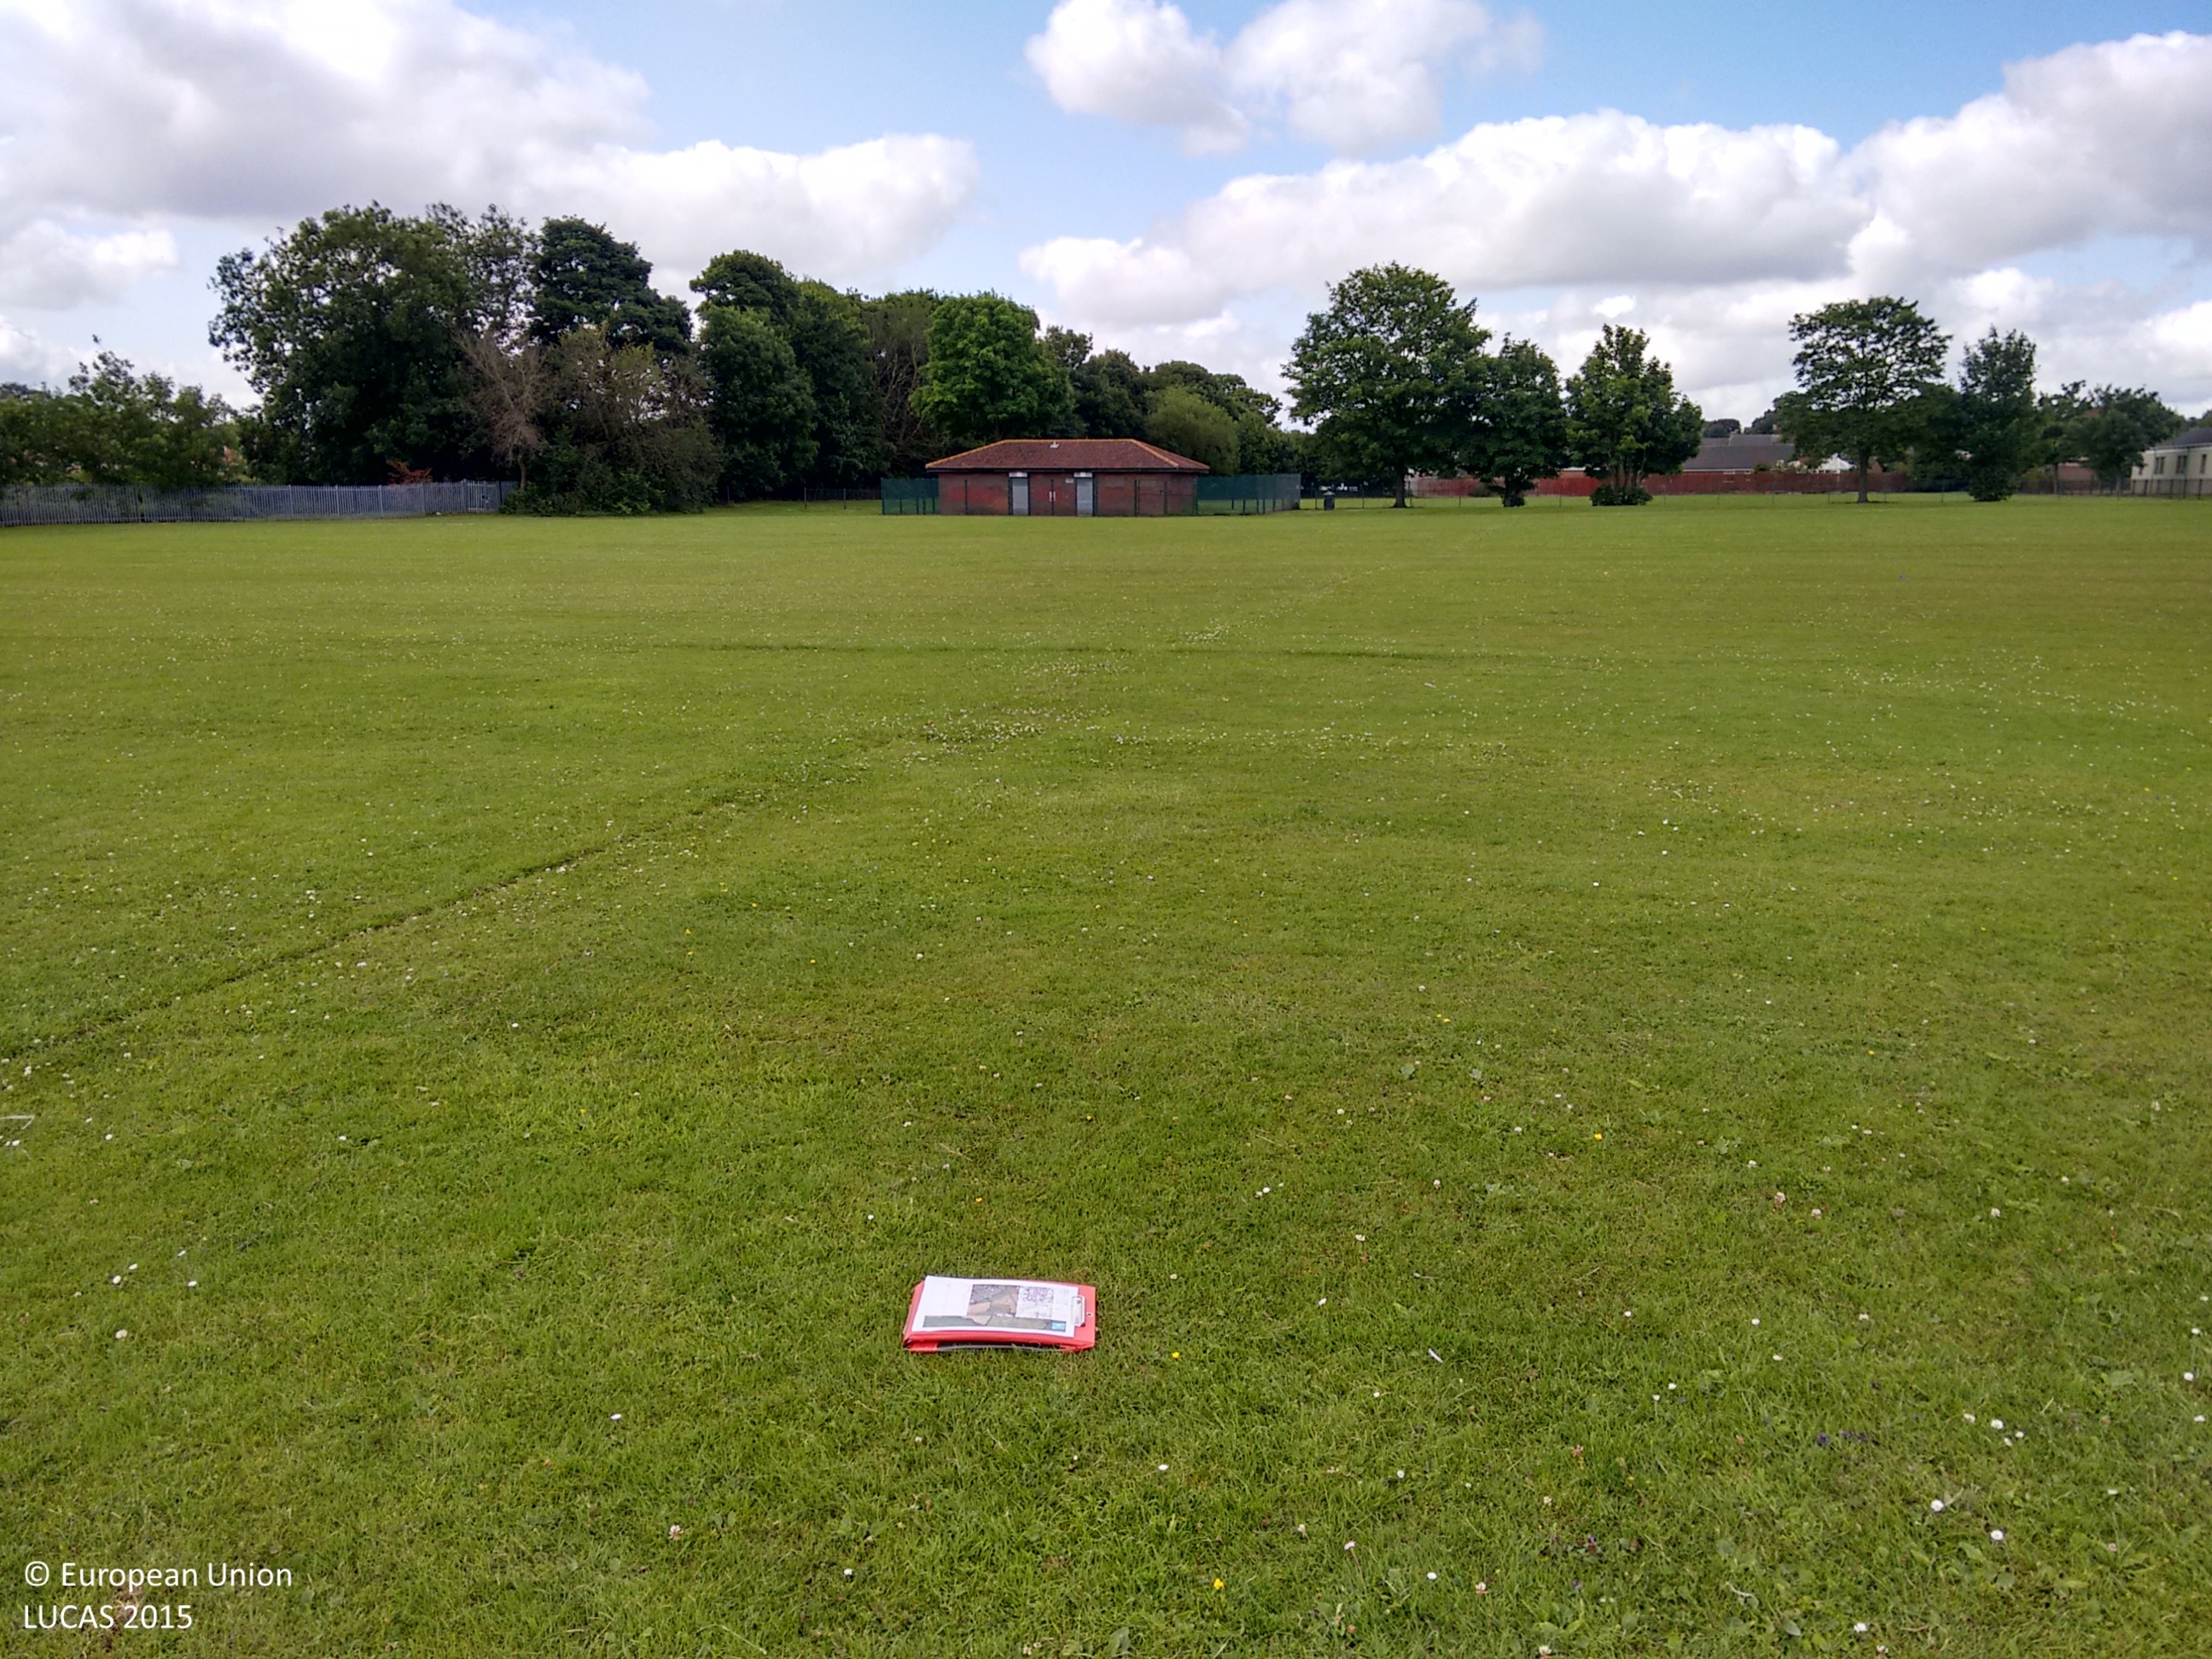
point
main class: Grassland
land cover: Grassland without tree/shrub cover
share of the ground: > 75 %
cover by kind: herbaceous plants 100 %
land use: Sport
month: July
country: GB
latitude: 53.4162
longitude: -2.7535
